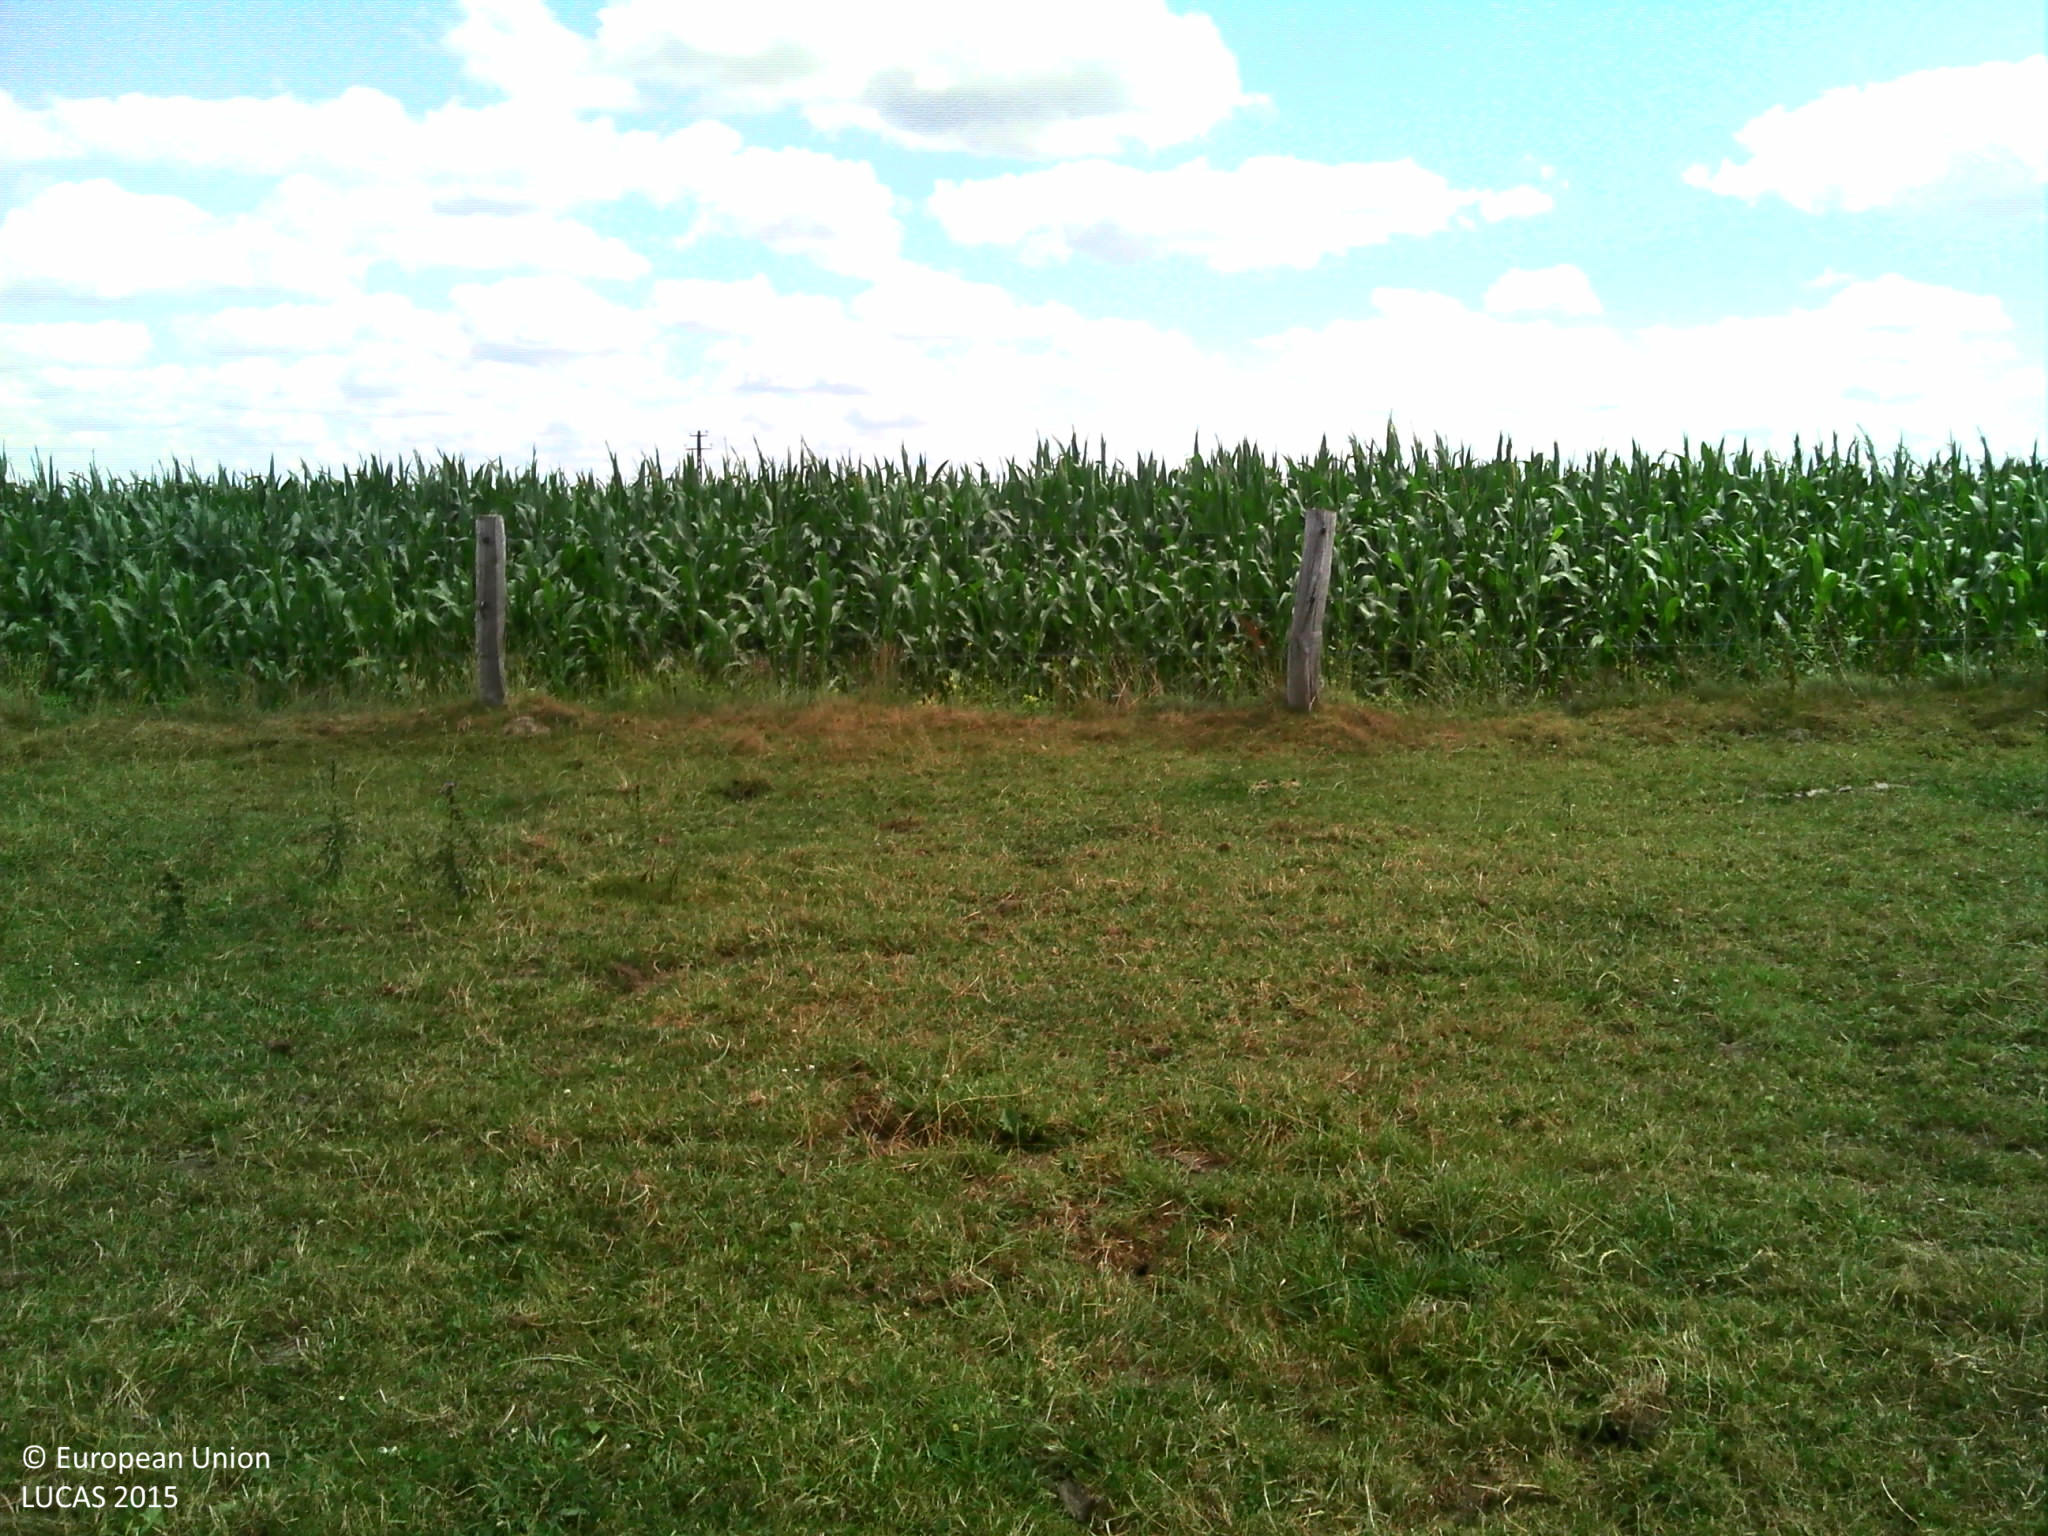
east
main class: Grassland
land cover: Grassland without tree/shrub cover
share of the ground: > 75 %
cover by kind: herbaceous plants 100 %
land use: Agriculture (excluding fallow land and kitchen gardens)
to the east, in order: Grassland without tree/shrub cover; Fences; Maize; Fences; Common wheat; Grassland without tree/shrub cover; Electric lines; Grassland without tree/shrub cover
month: July
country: BE
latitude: 49.9968
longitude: 5.7439
